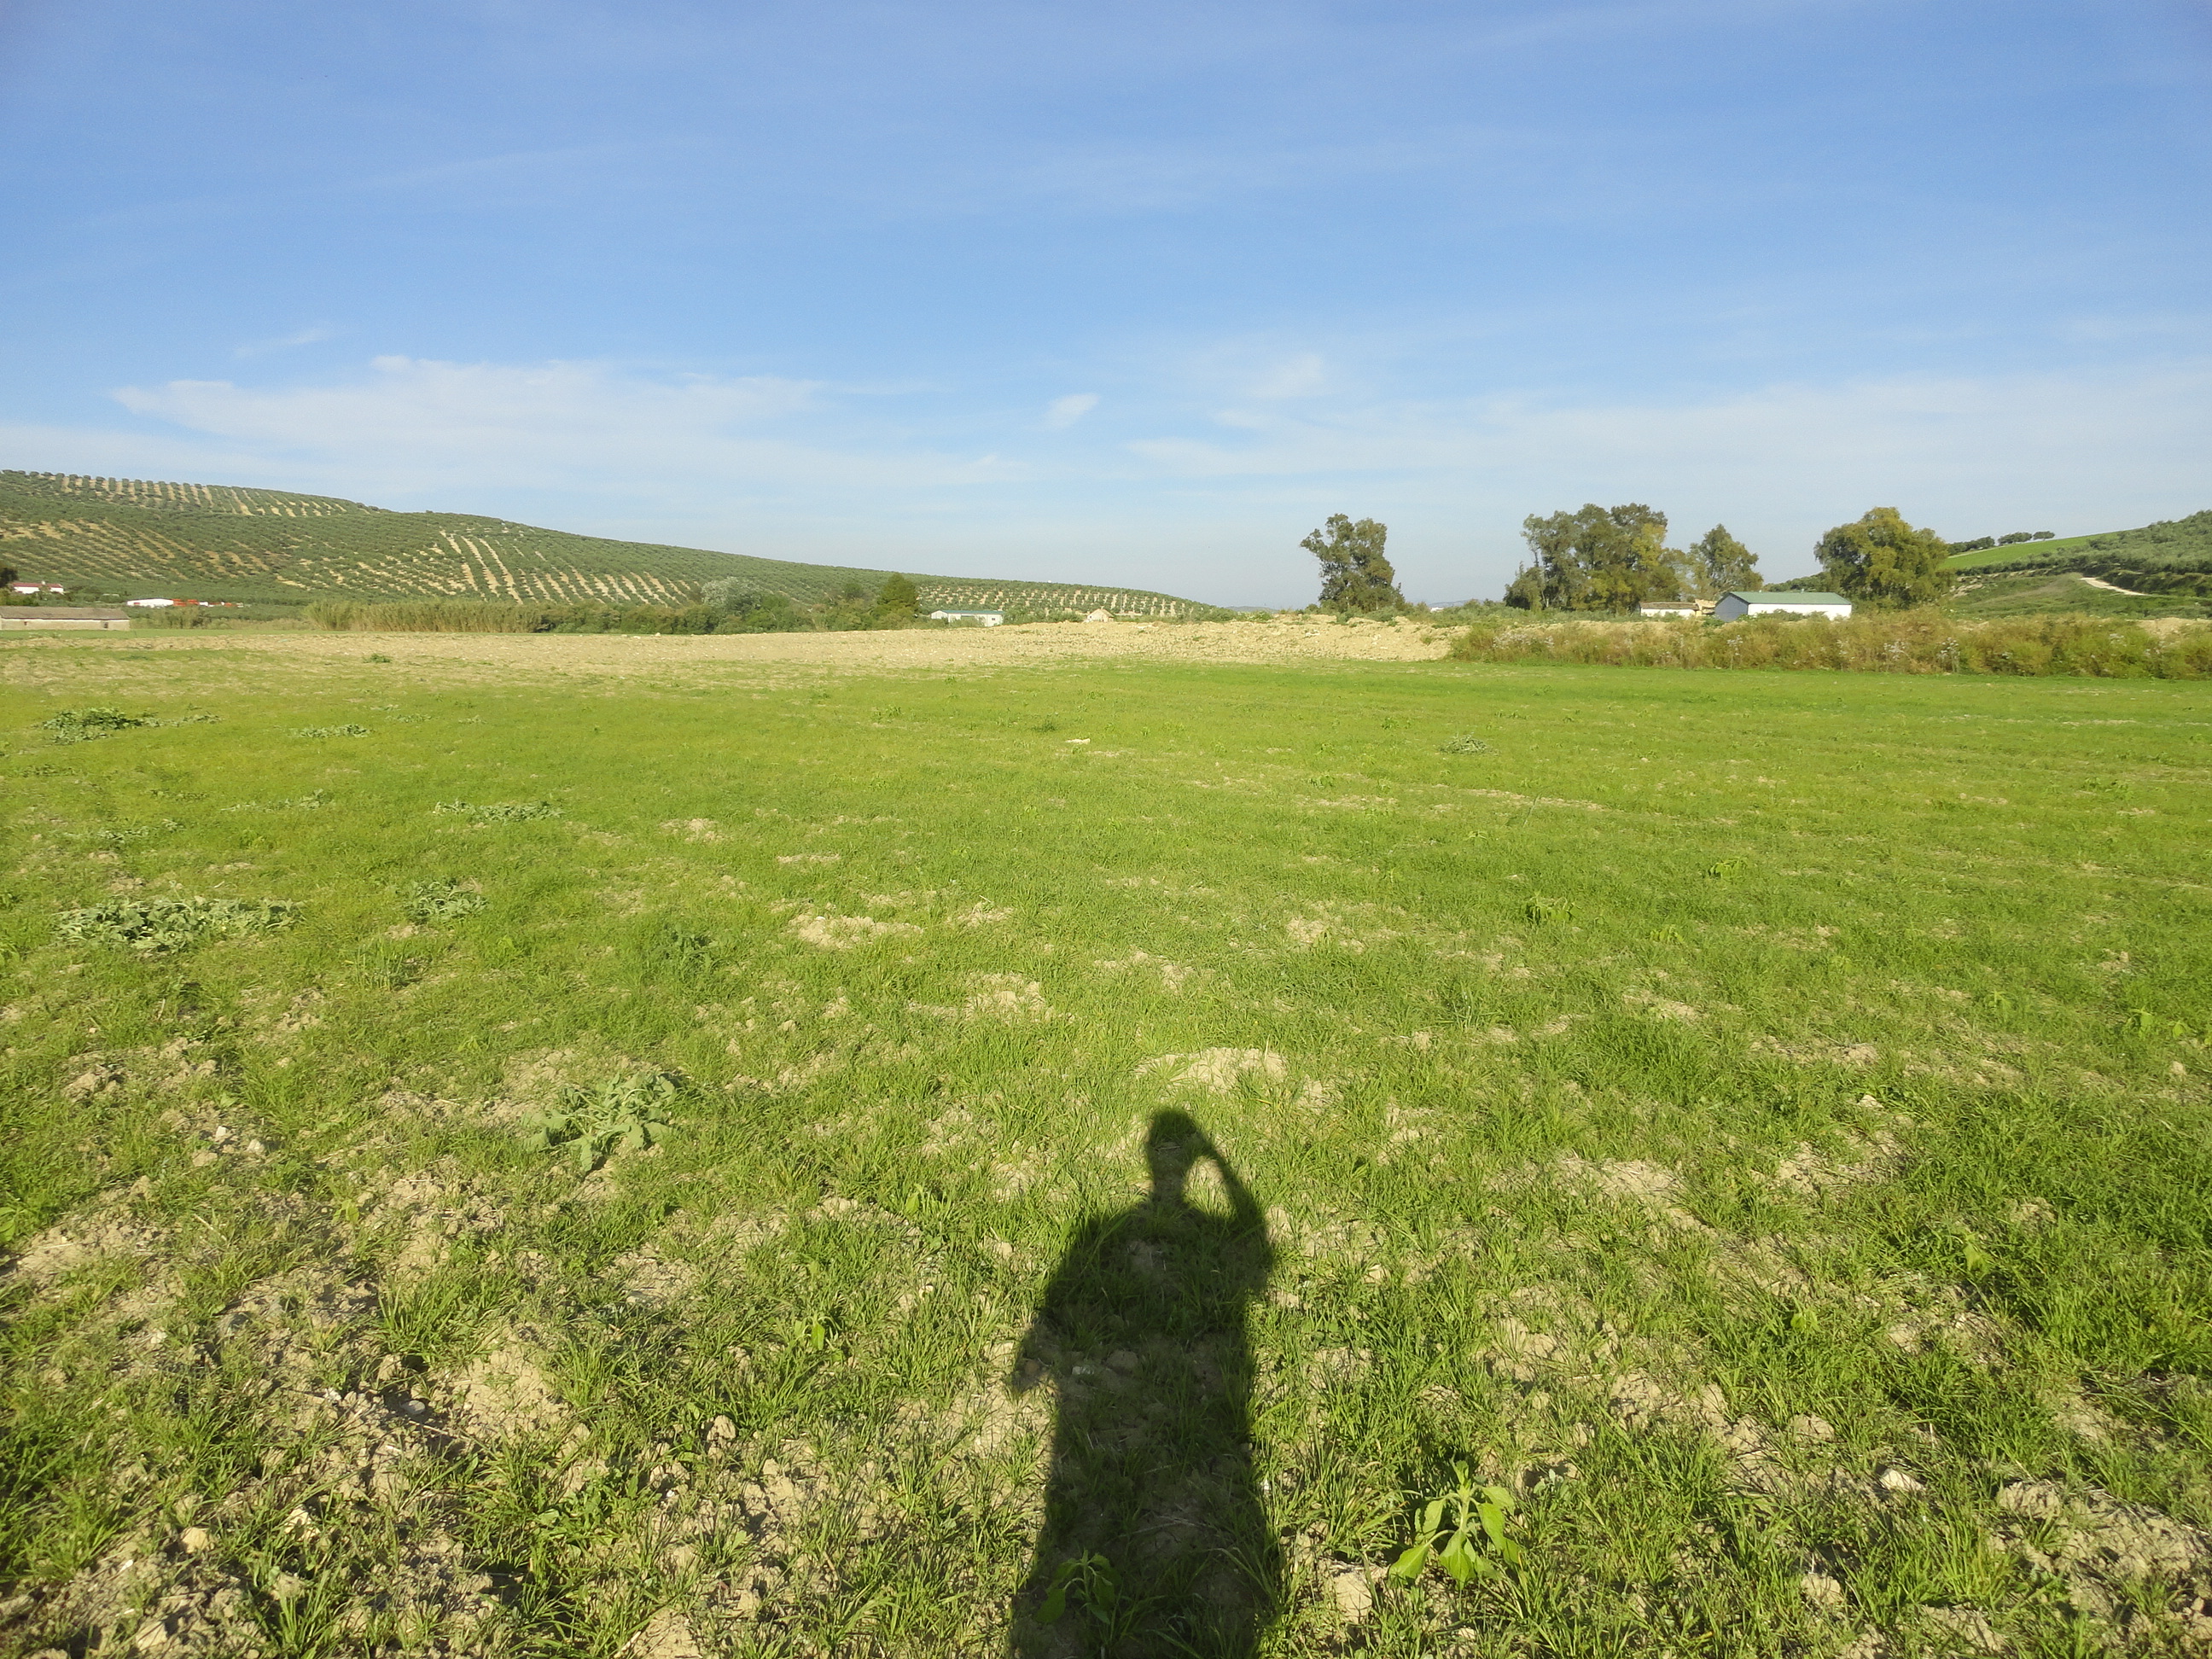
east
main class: Grassland
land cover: Spontaneously vegetated surfaces
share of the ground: 50 - 75 %
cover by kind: herbaceous plants 80 %, unconsolidated bare surface 20 %
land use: Fallow land
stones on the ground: < 10 %
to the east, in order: Spontaneously vegetated surfaces; Rivers and streams; Tracks; Grass margins; Durum wheat; Abandoned hedges; Durum wheat
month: April
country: ES
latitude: 37.6942
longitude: -4.5129
